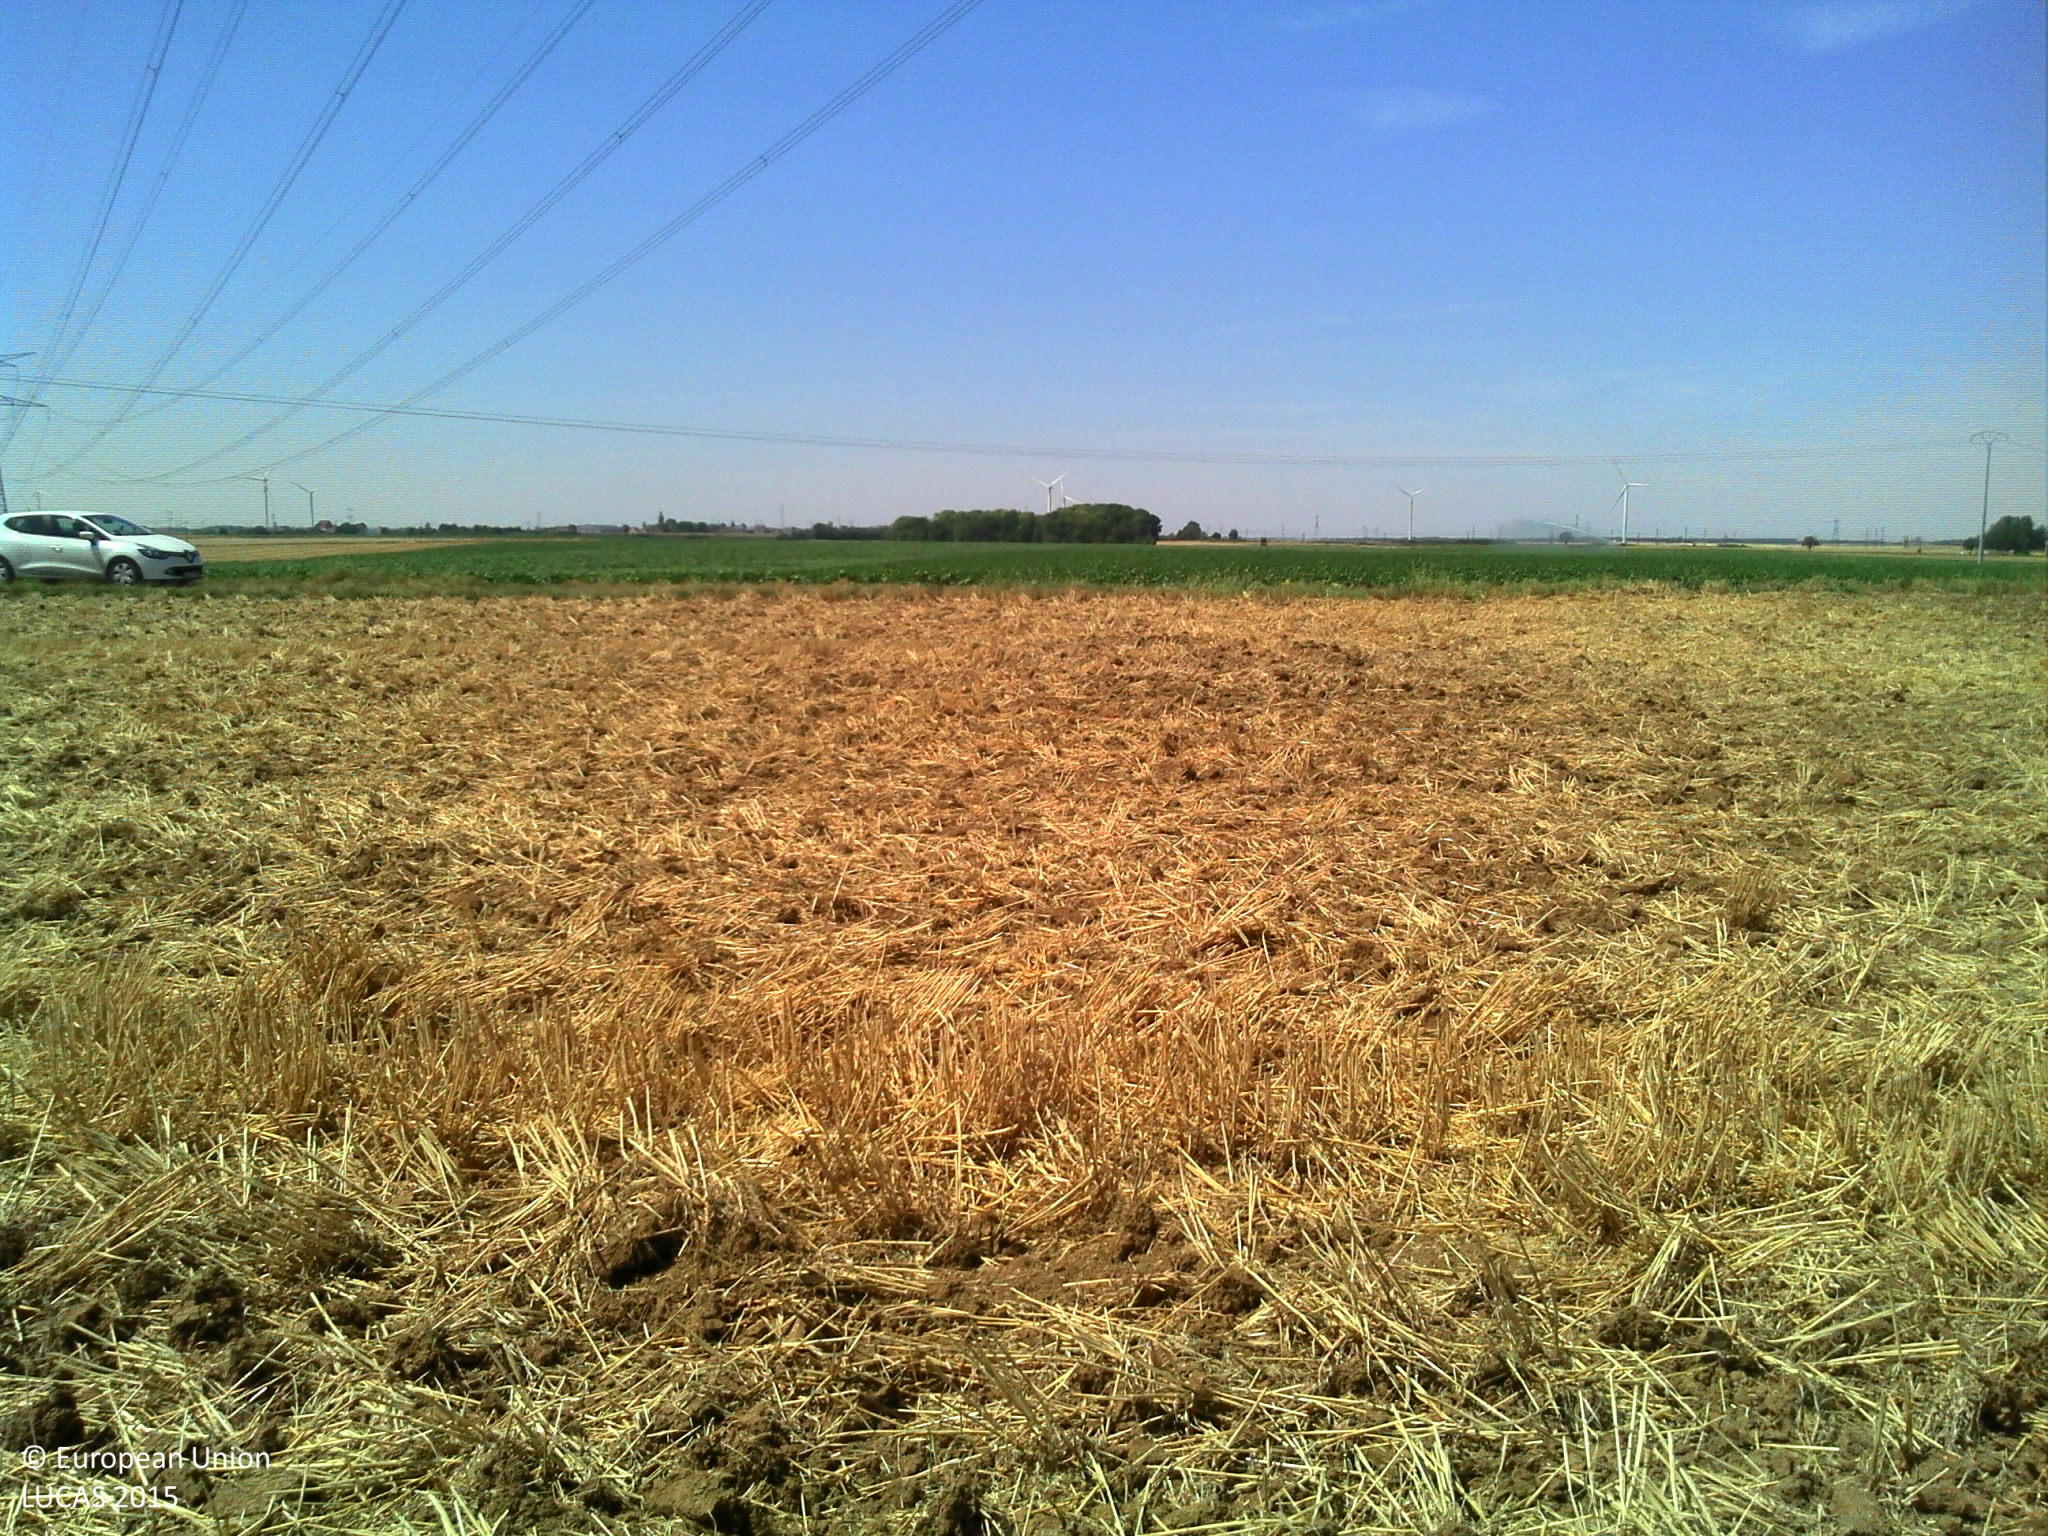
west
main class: Cropland
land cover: Triticale
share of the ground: > 75 %
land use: Agriculture (excluding fallow land and kitchen gardens)
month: August
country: FR
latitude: 48.1448
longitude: 1.9363
